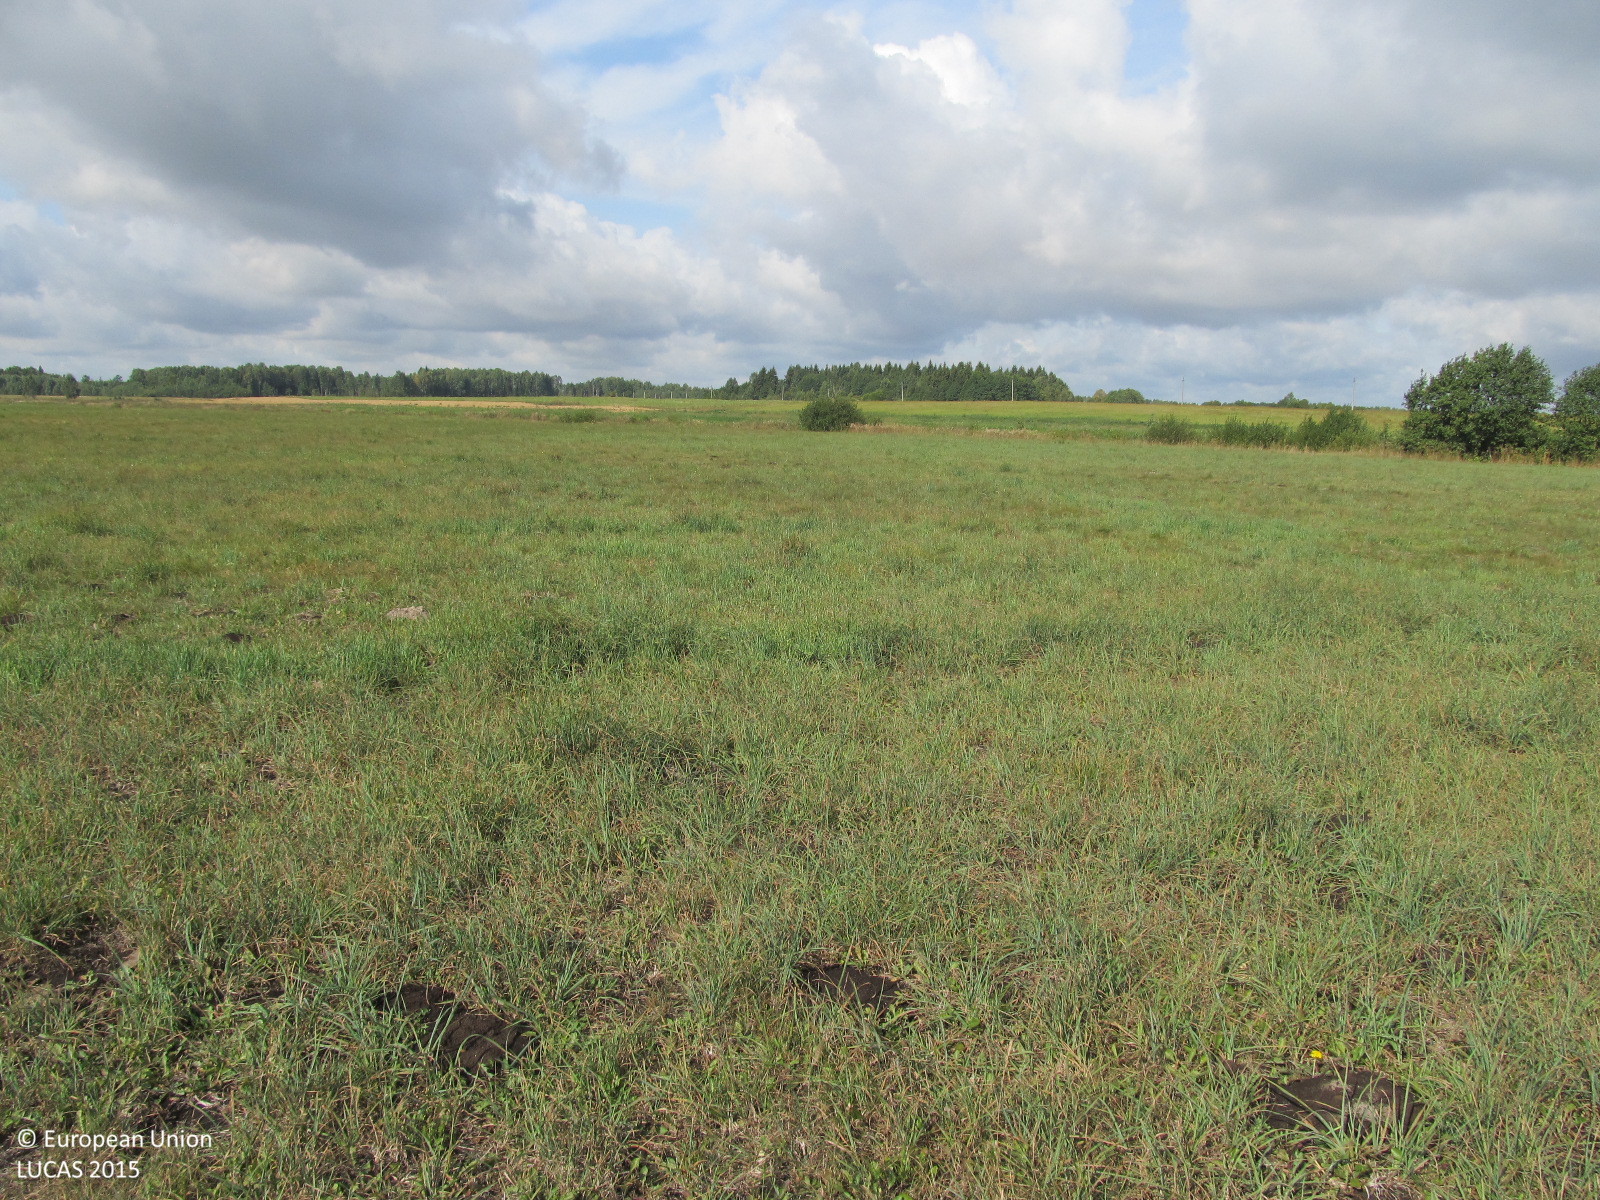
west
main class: Grassland
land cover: Grassland without tree/shrub cover
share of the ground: > 75 %
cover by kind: herbaceous plants 100 %
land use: Agriculture (excluding fallow land and kitchen gardens)
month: August
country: LT
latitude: 55.7279
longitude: 23.3064
